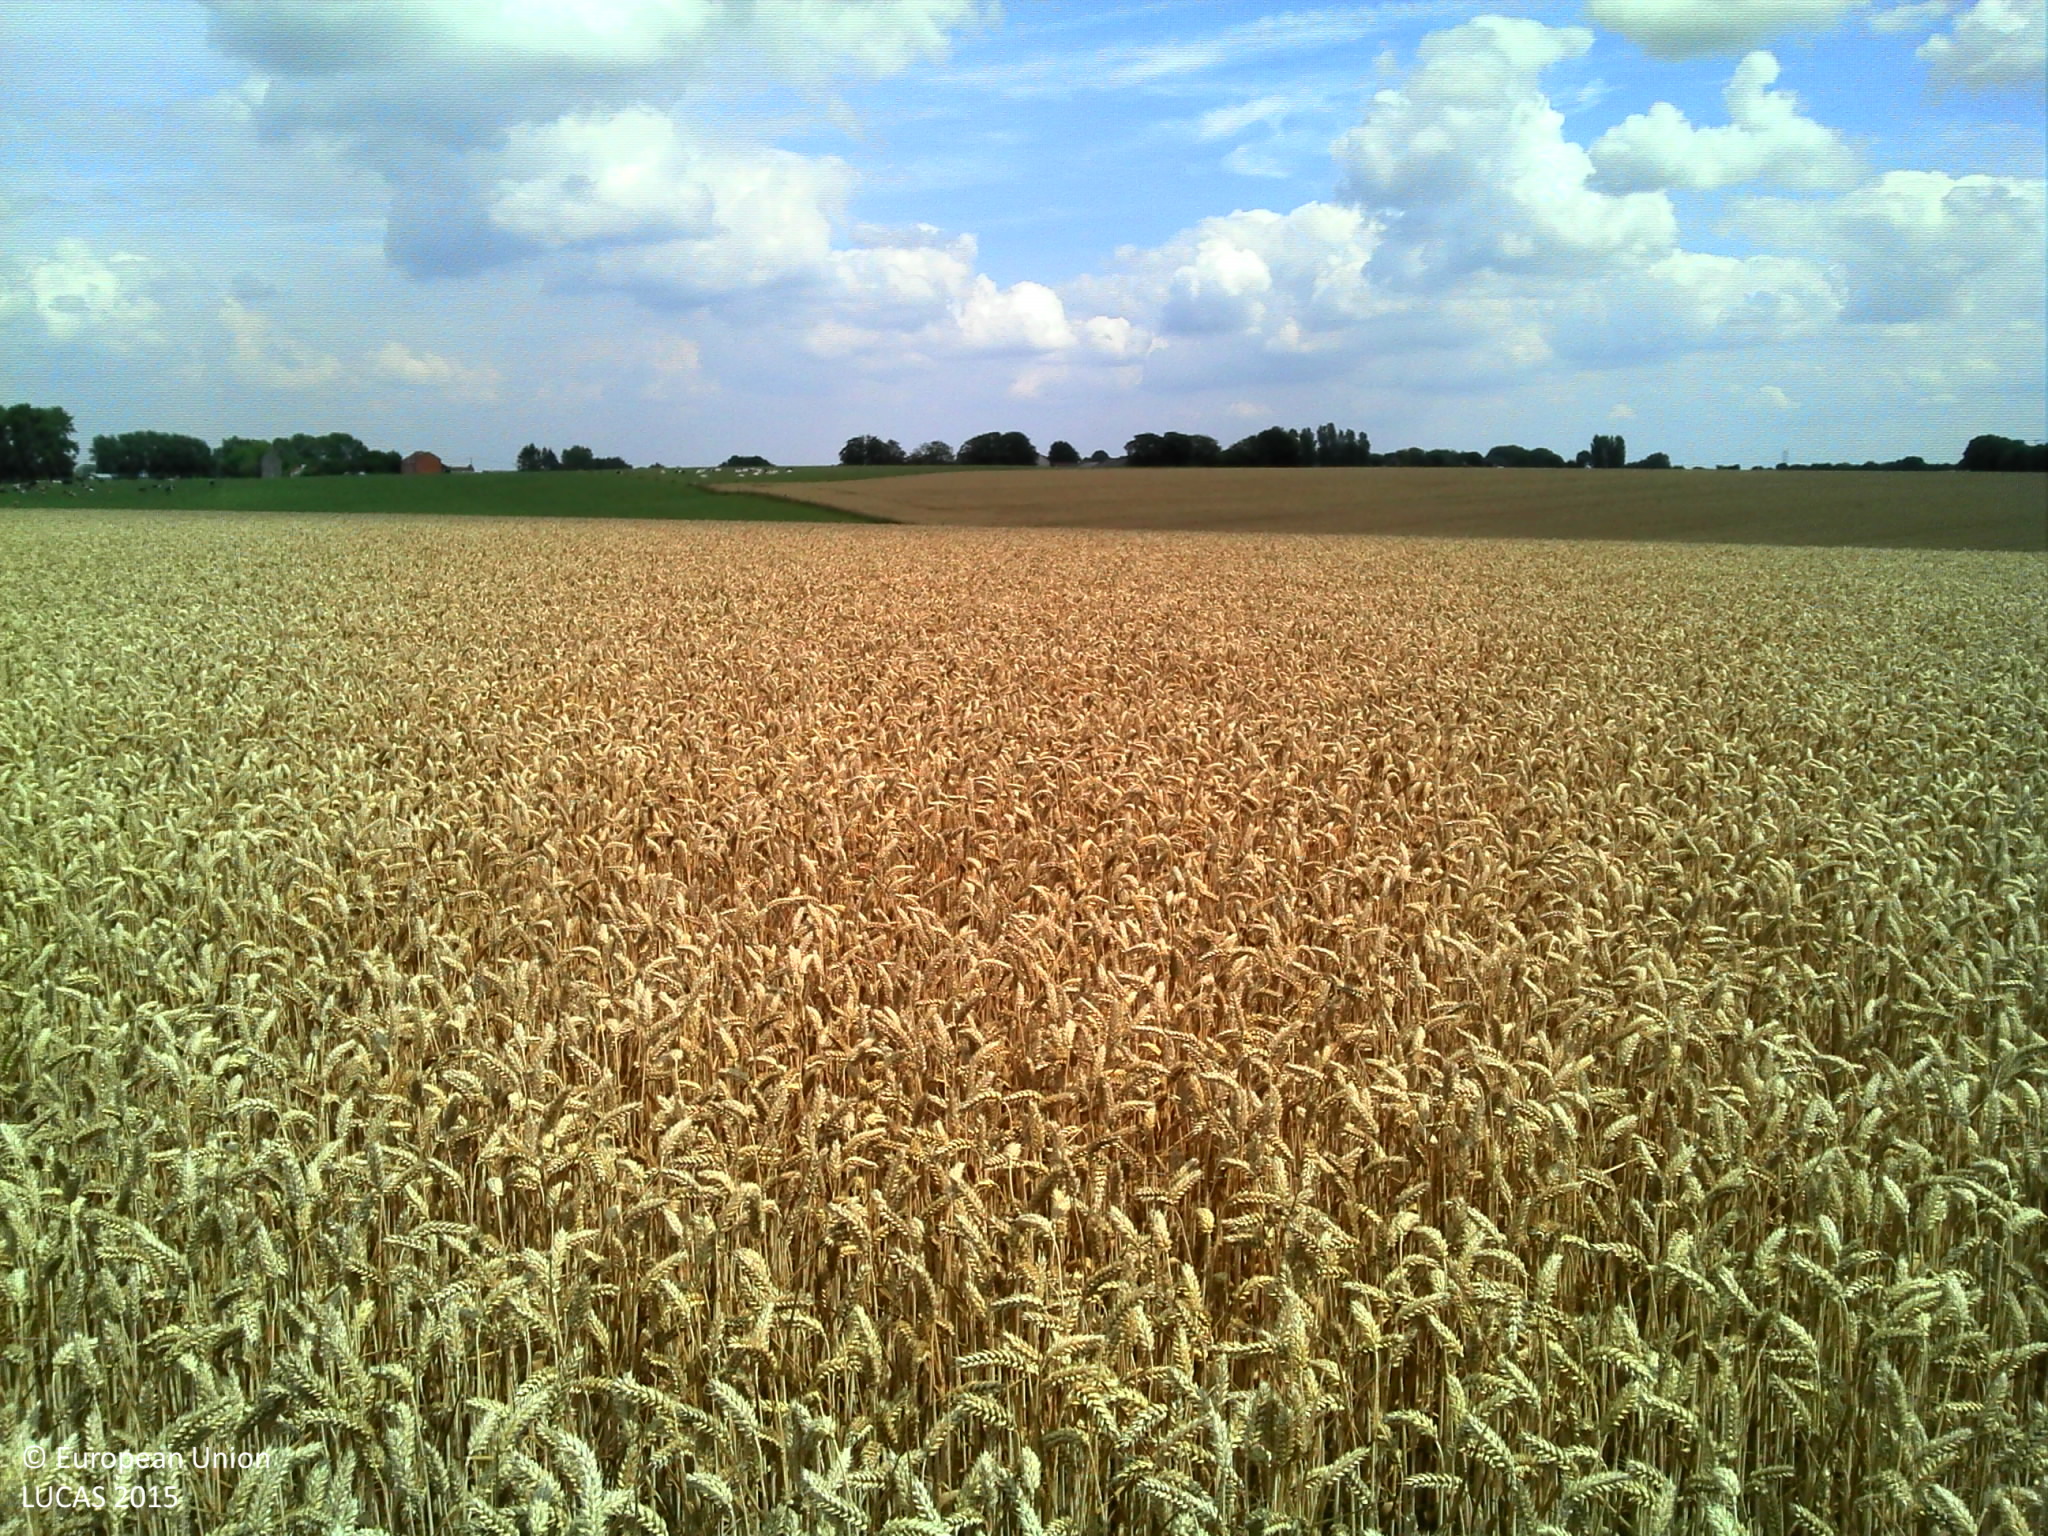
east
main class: Cropland
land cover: Common wheat
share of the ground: > 75 %
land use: Agriculture (excluding fallow land and kitchen gardens)
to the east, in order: Common wheat
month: July
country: BE
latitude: 50.5661
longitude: 4.3340
